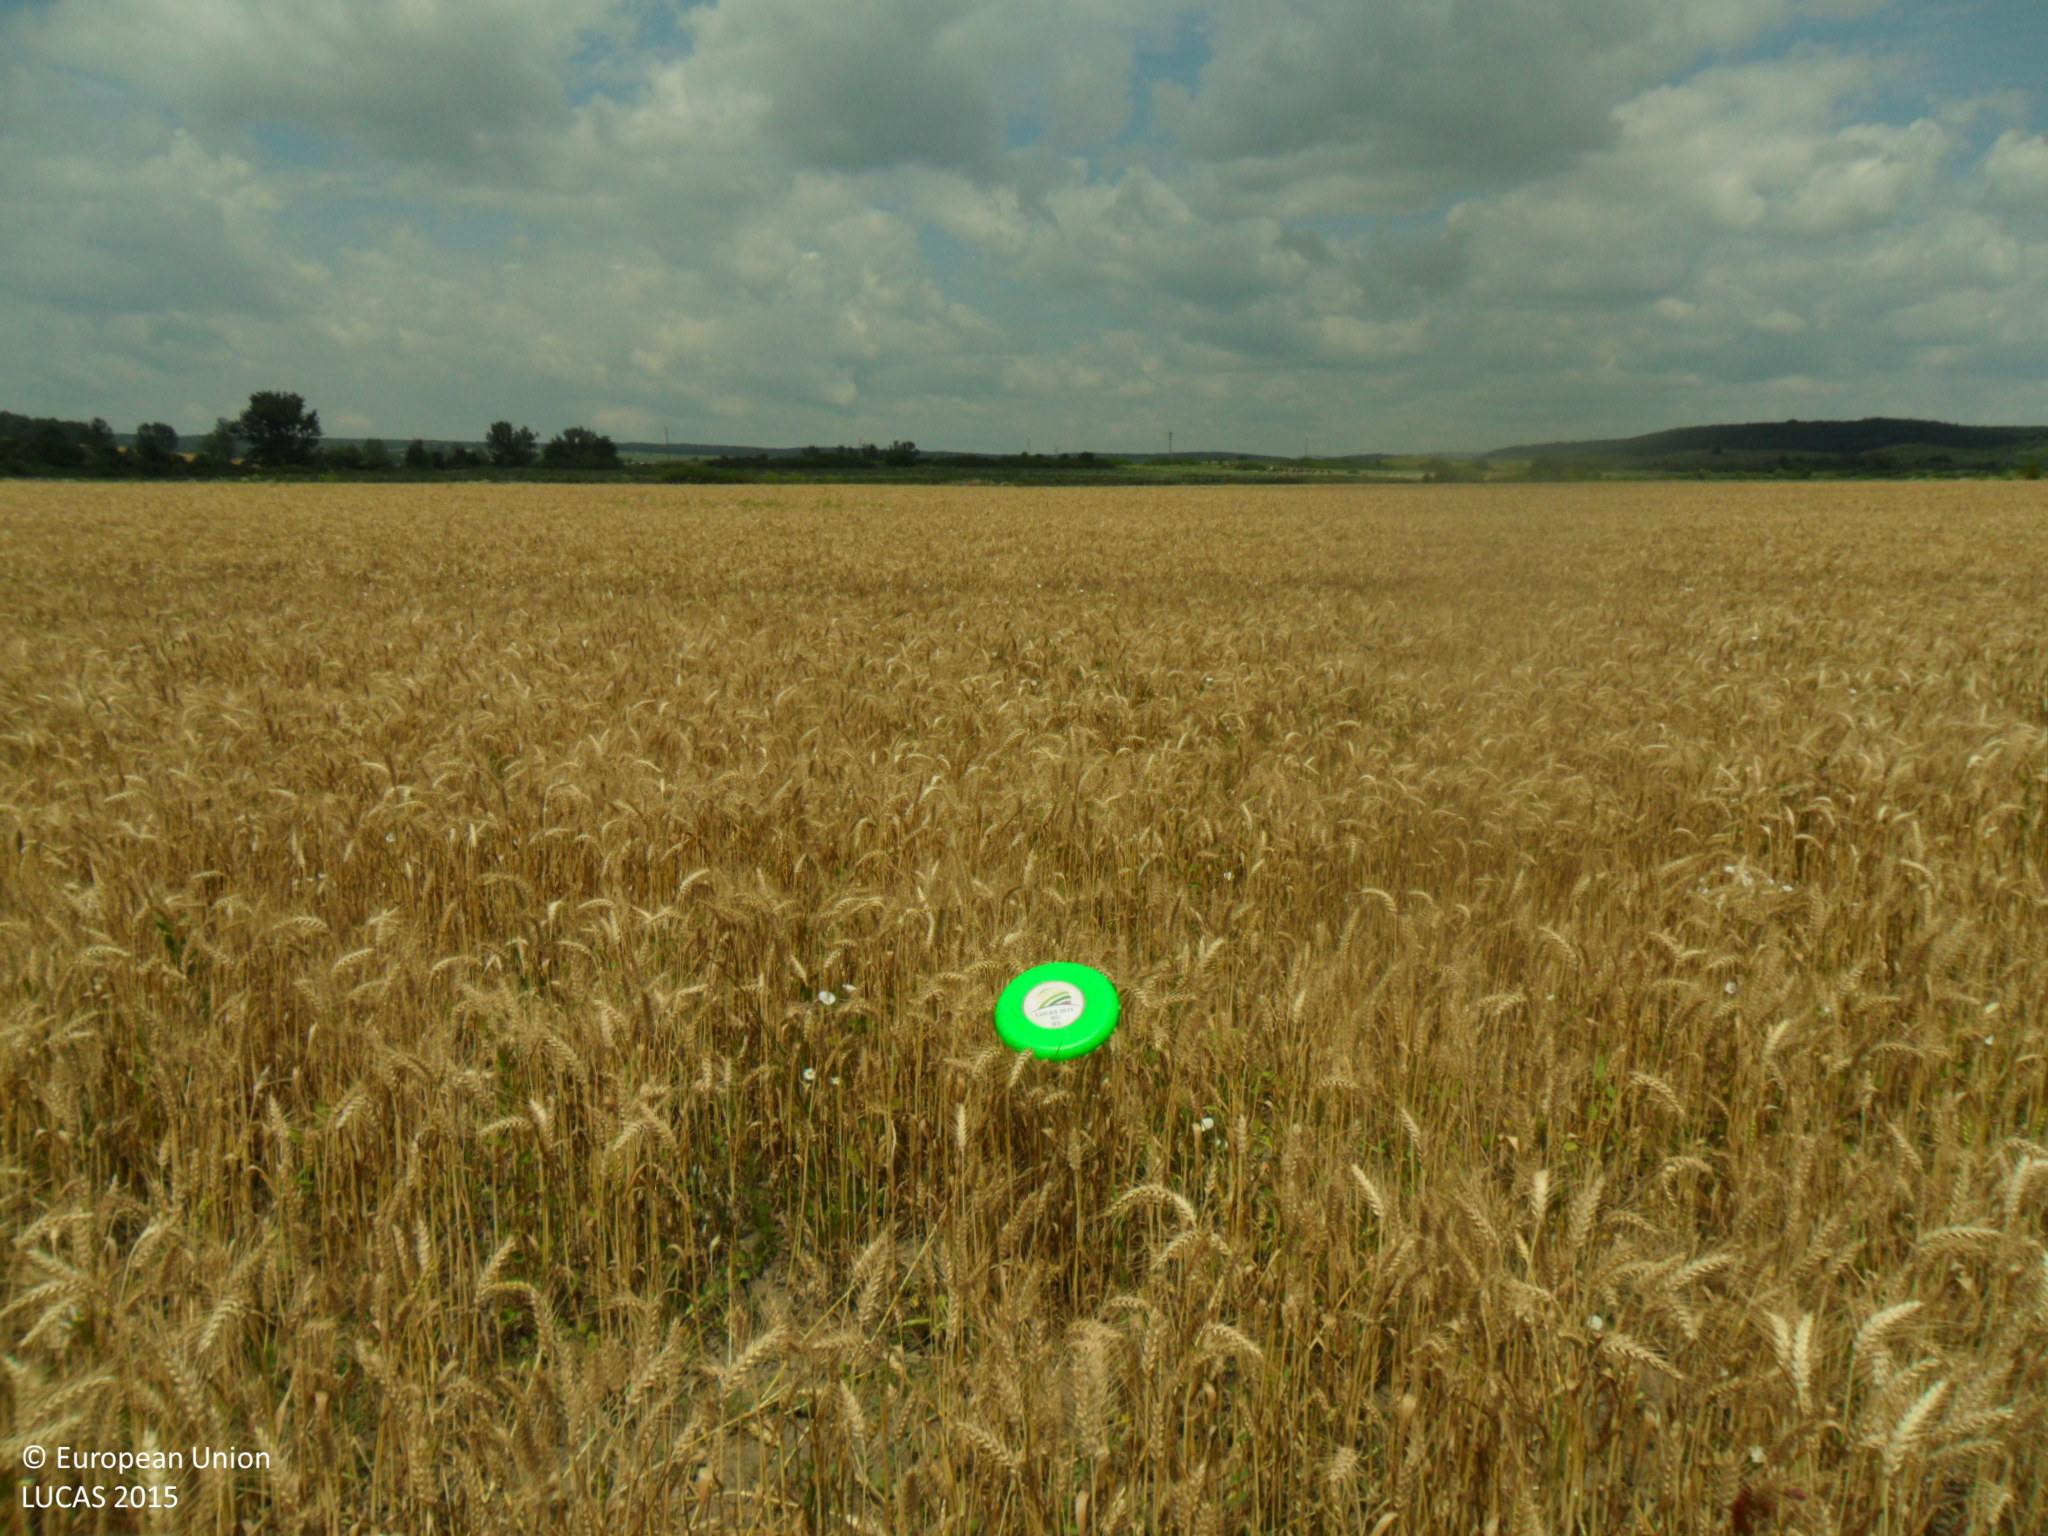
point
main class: Cropland
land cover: Common wheat
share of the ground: > 75 %
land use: Agriculture (excluding fallow land and kitchen gardens)
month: June
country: BG
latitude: 43.1254
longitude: 26.9638
